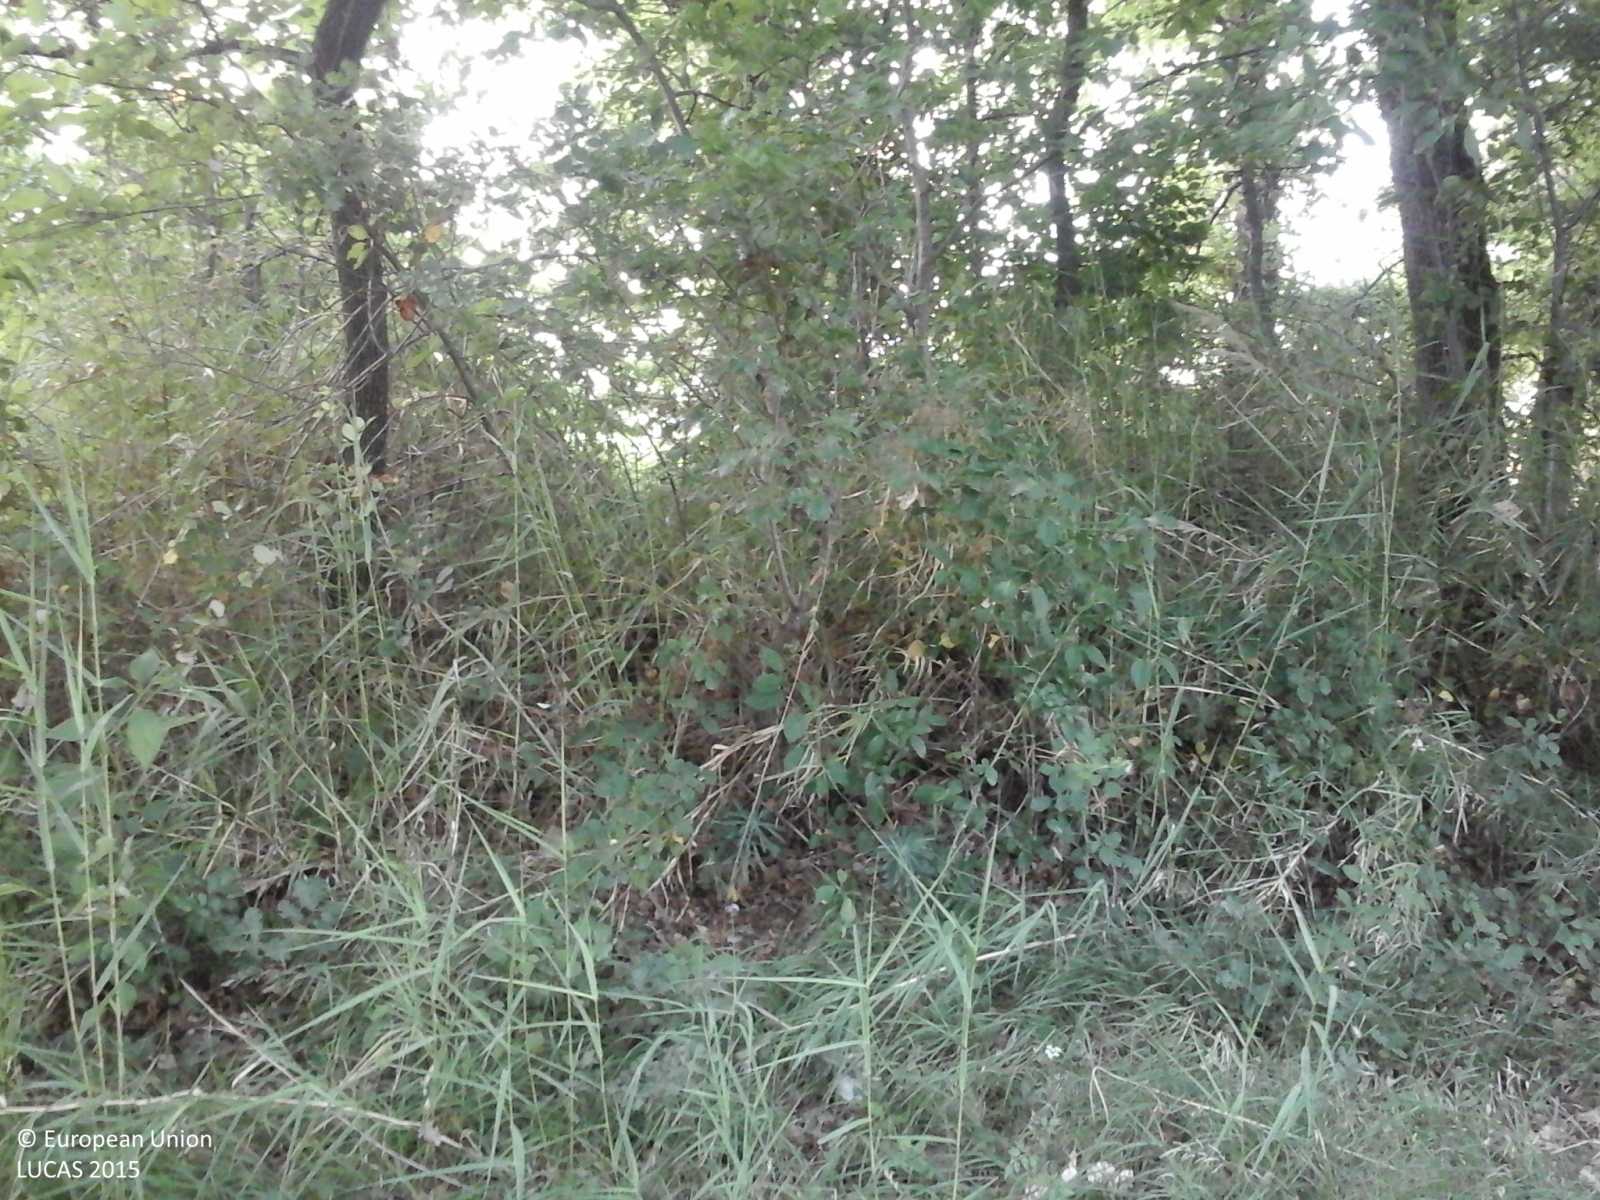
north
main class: Woodland
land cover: Broadleaved woodland
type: thermophilous deciduous forest
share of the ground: > 75 %
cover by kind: broadleaved forest trees 80 %, shrubs 10 %, herbaceous plants 10 %
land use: Semi-natural and natural areas not in use
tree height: > 5 m
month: June
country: IT
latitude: 42.0743
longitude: 14.3013
